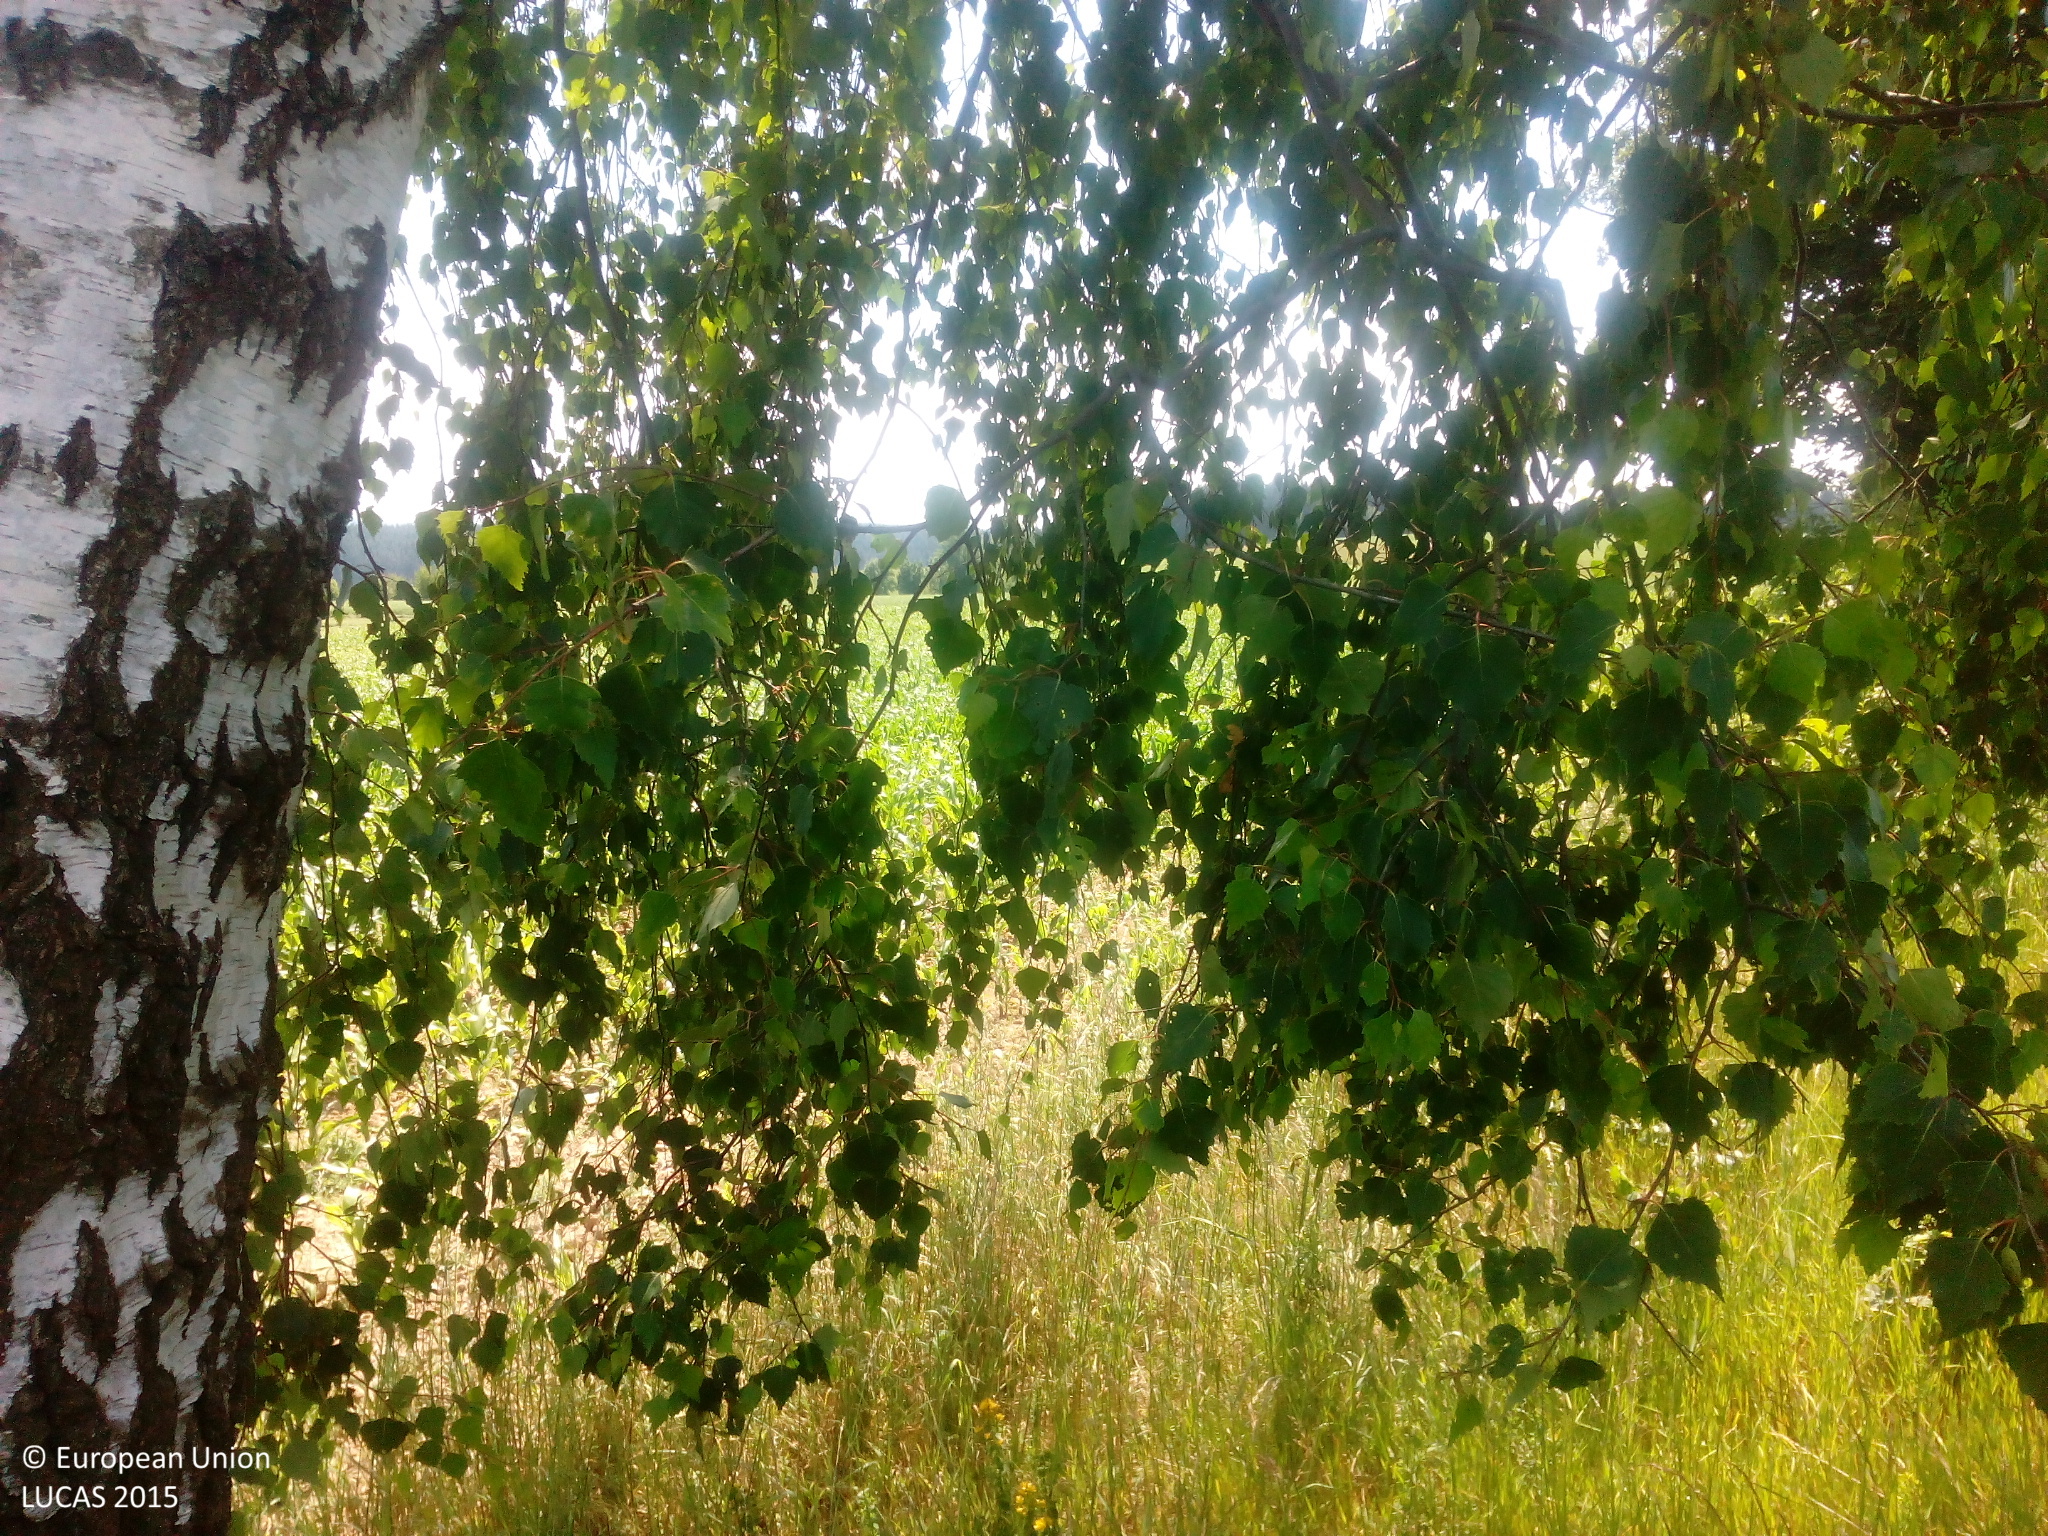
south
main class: Woodland
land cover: Broadleaved woodland
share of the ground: 25 - 50 %
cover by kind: herbaceous plants 75 %, broadleaved forest trees 25 %
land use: Road transport
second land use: Agriculture (excluding fallow land and kitchen gardens)
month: June
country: DE
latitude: 50.1482
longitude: 12.0288
